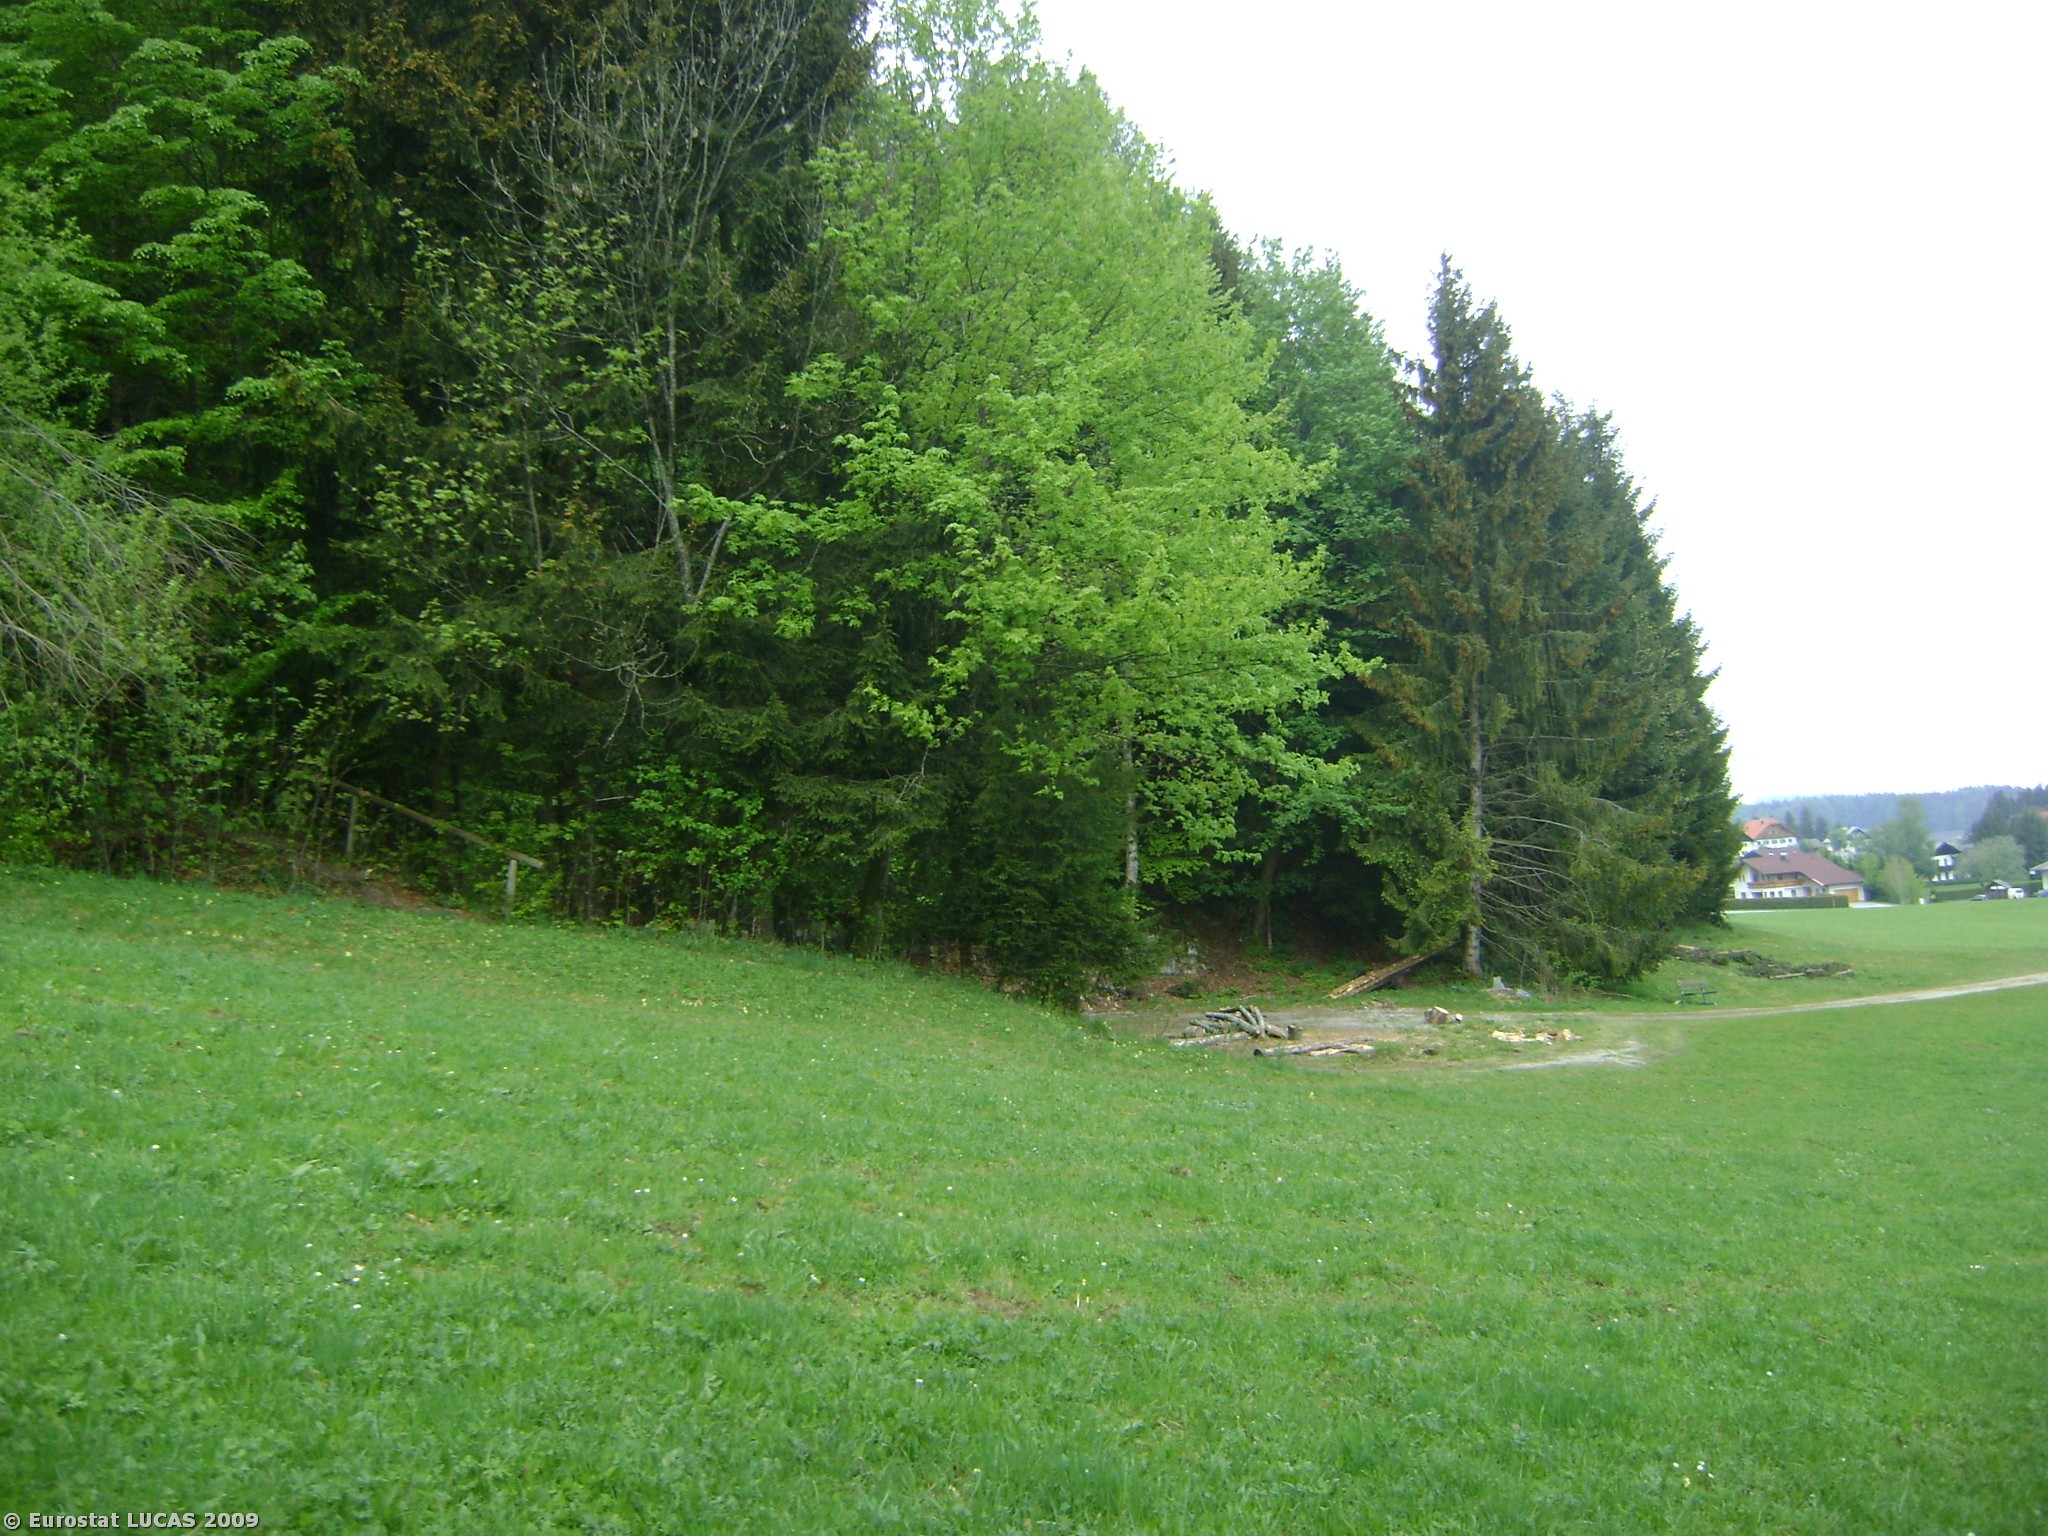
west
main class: Grassland
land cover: Grassland without tree/shrub cover
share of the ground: > 75 %
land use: Agriculture (excluding fallow land and kitchen gardens)
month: May
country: AT
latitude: 47.8164
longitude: 13.2173
